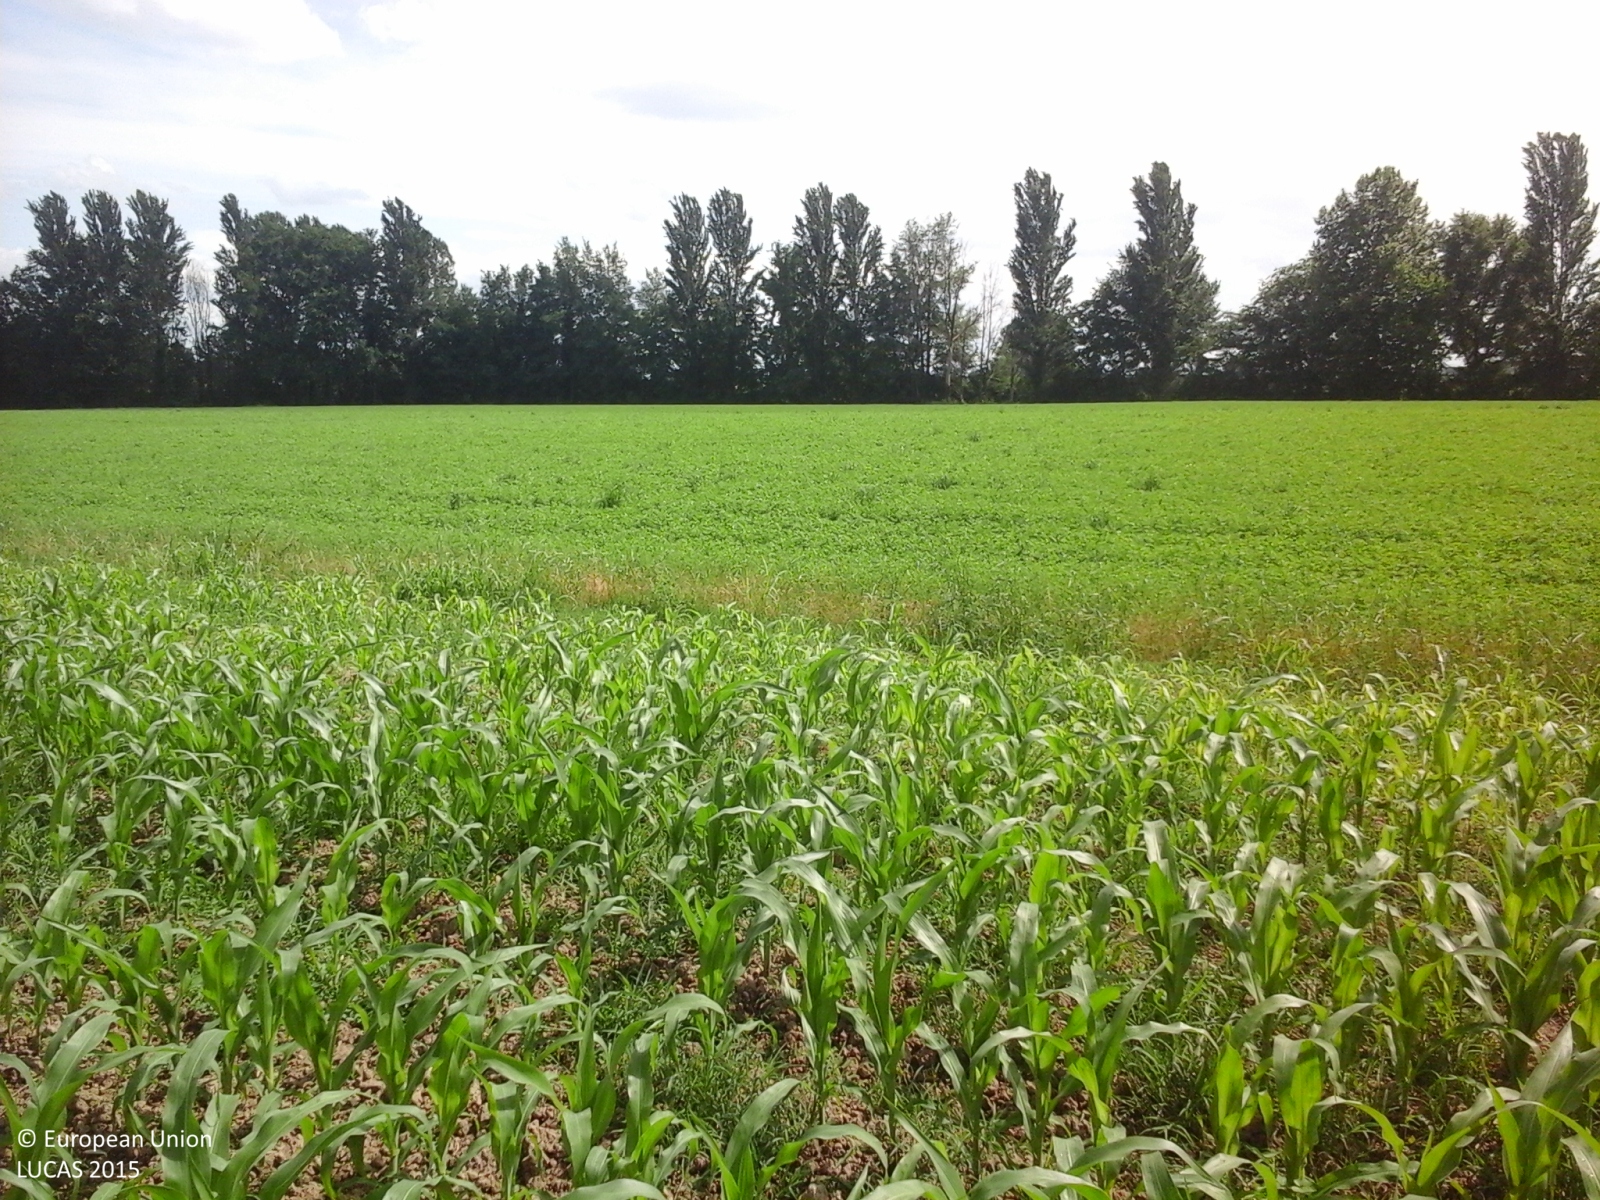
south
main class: Cropland
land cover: Maize
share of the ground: 25 - 50 %
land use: Agriculture (excluding fallow land and kitchen gardens)
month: May
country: IT
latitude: 45.0693
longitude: 10.7226
